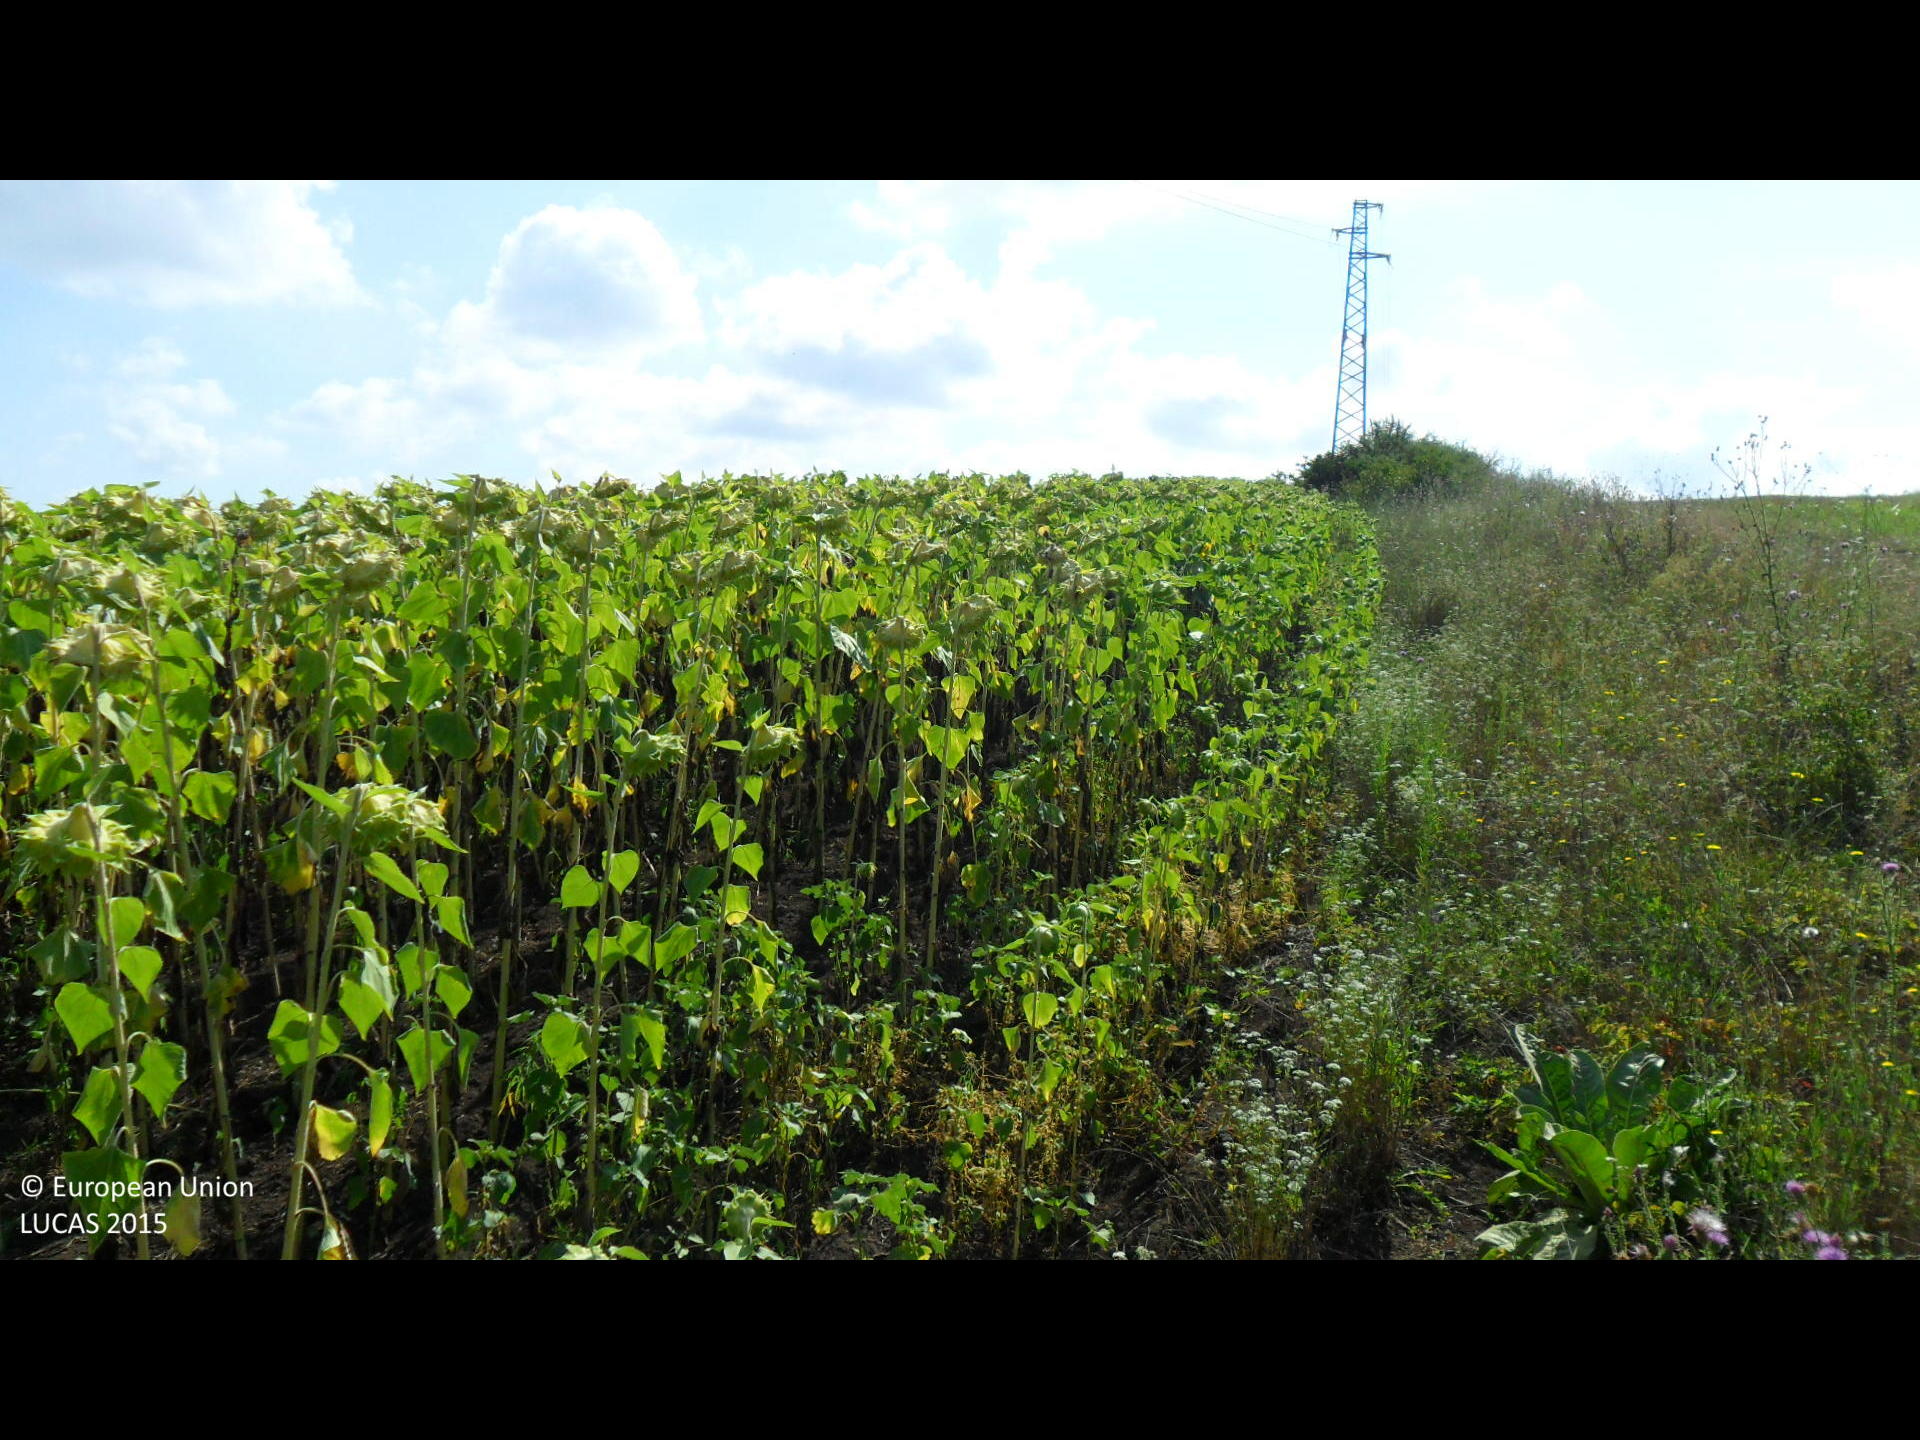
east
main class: Cropland
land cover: Sunflower
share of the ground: > 75 %
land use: Agriculture (excluding fallow land and kitchen gardens)
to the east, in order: Sunflower
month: August
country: BG
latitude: 43.3987
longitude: 26.3102
